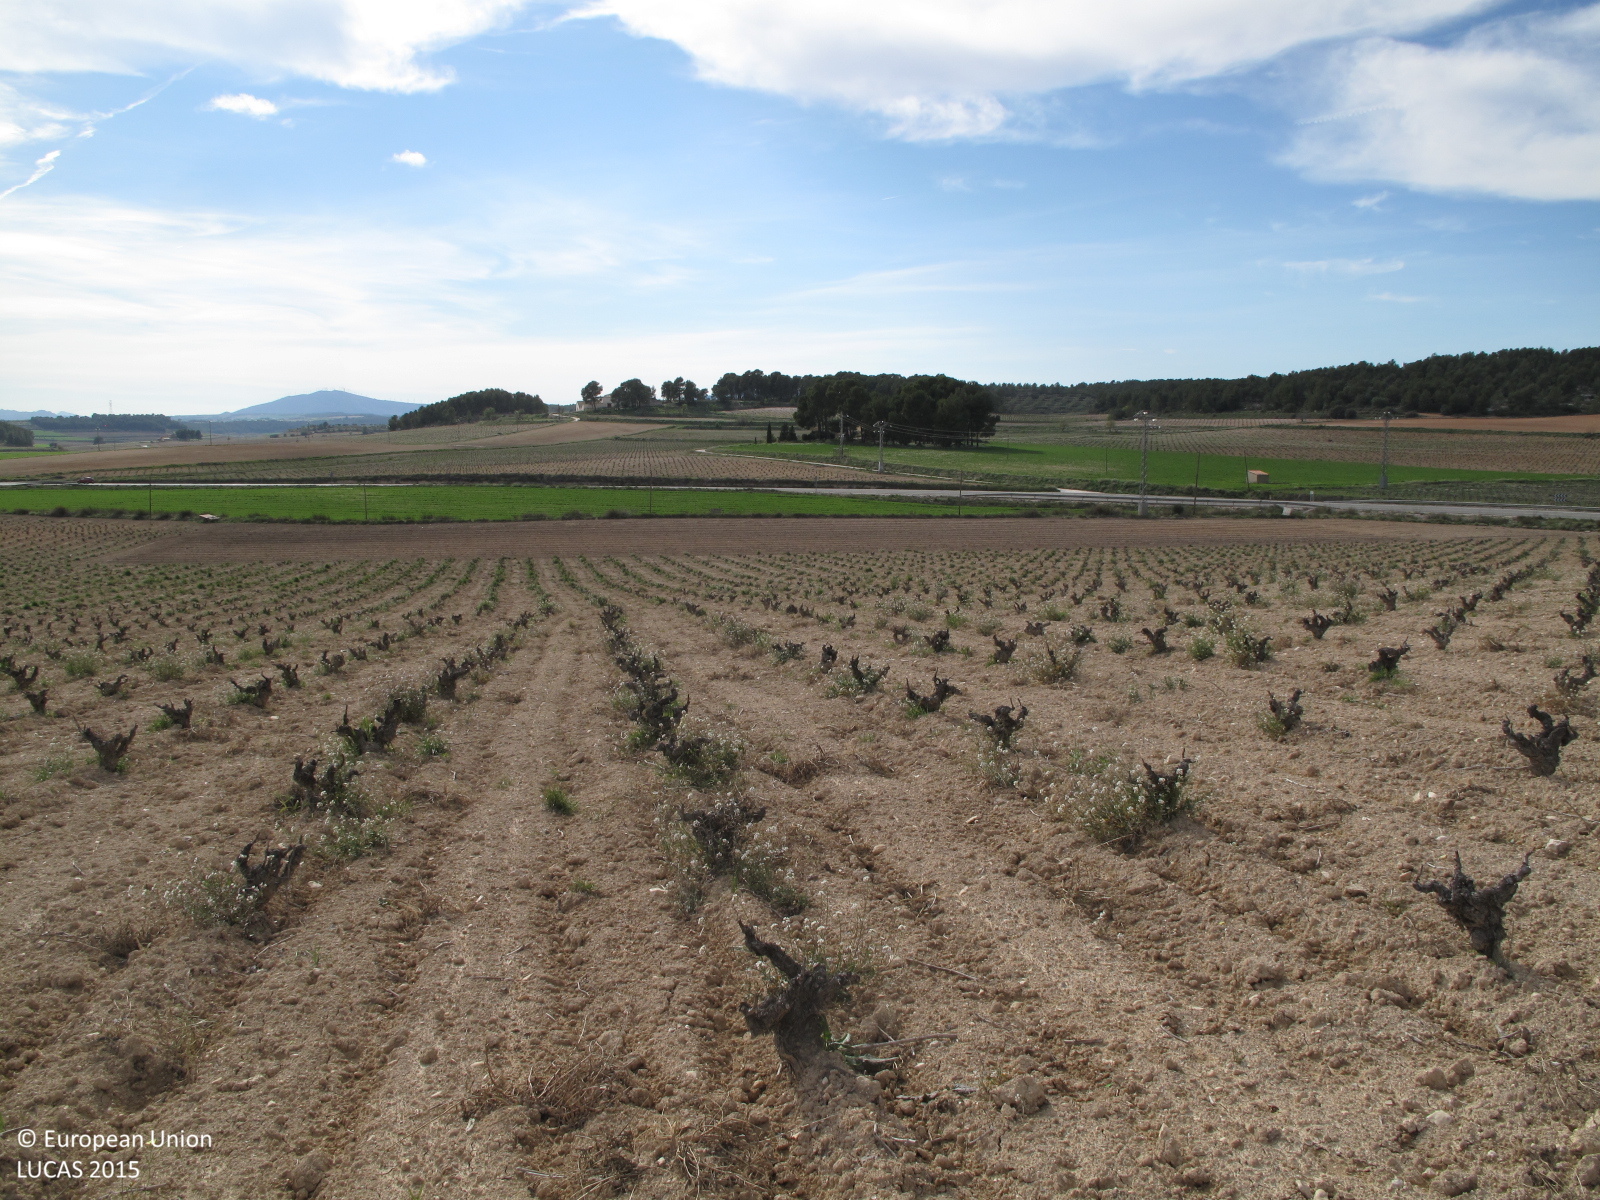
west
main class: Cropland
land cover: Vineyards
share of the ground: < 10 %
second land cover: Other bare soil
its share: > 75 %
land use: Agriculture (excluding fallow land and kitchen gardens)
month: March
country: ES
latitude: 38.7956
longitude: -0.7800
